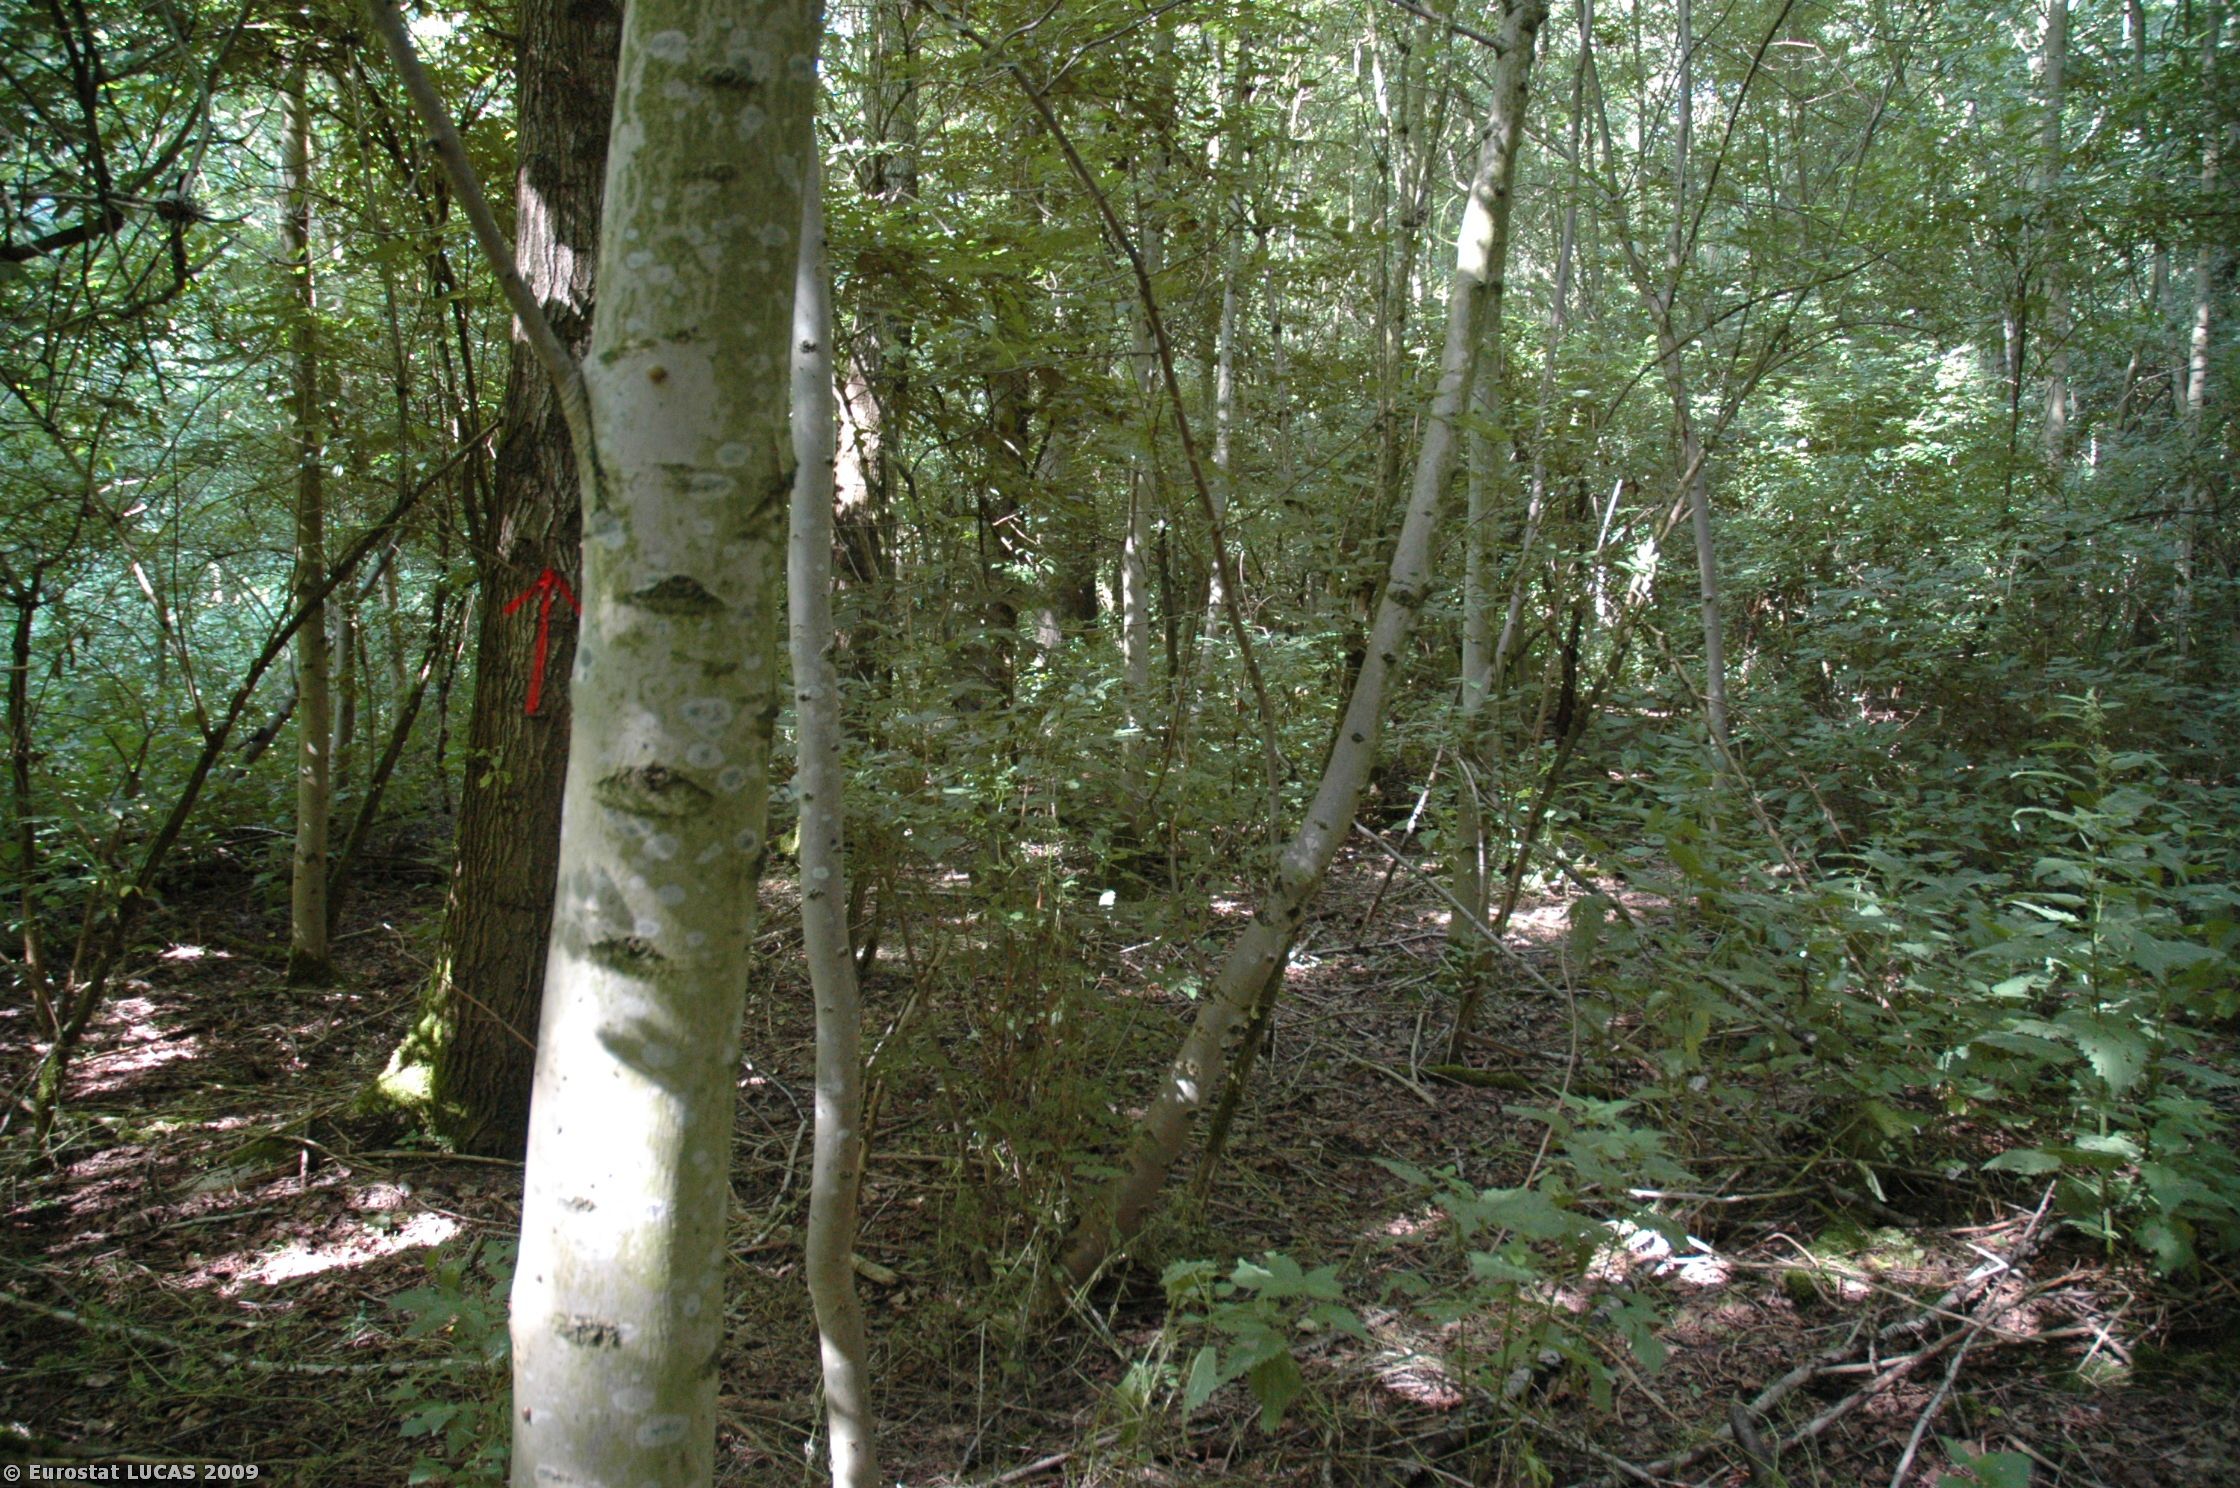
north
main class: Woodland
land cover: Broadleaved woodland
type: plantations and self-sown exotic forest
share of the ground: > 75 %
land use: Nature reserves
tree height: > 5 m
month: June
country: NL
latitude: 52.3738
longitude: 5.2829
